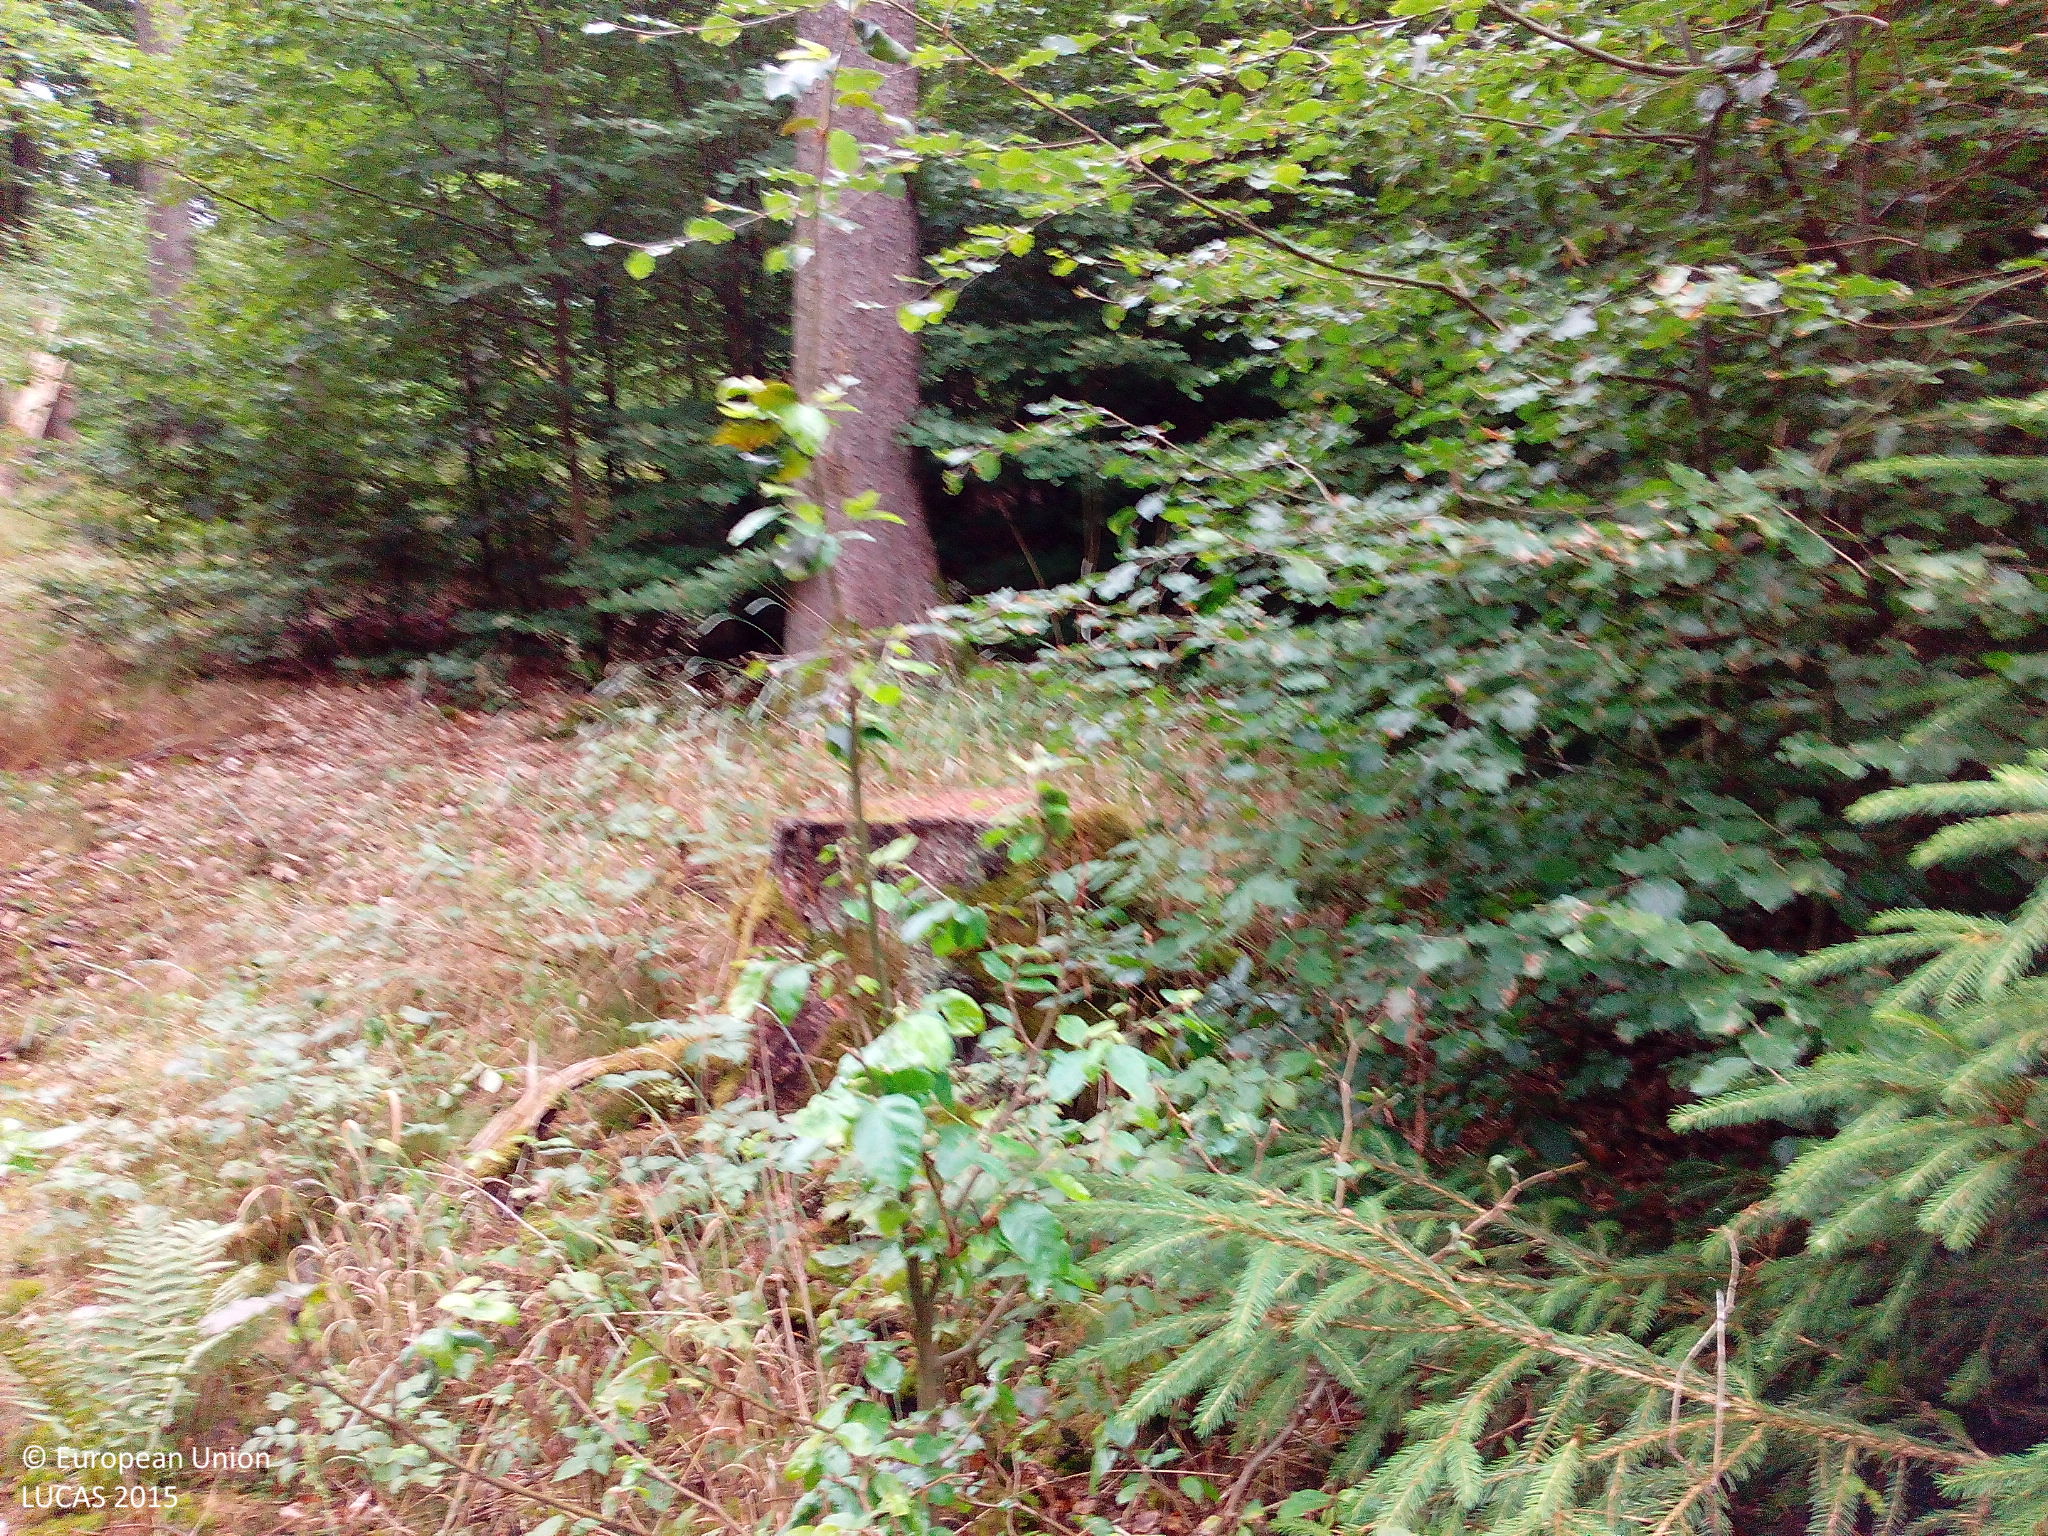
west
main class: Woodland
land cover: Spruce dominated mixed woodland
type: hemiboreal forest and nemoral coniferous forest and mixed broadleaved-coniferous forest
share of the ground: > 75 %
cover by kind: coniferous forest trees 40 %, broadleaved forest trees 30 %, unconsolidated bare surface 20 %, herbaceous plants 5 %, lichens and mosses 5 %
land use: Forestry
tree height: > 5 m
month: July
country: DE
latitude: 51.0292
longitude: 9.8717
